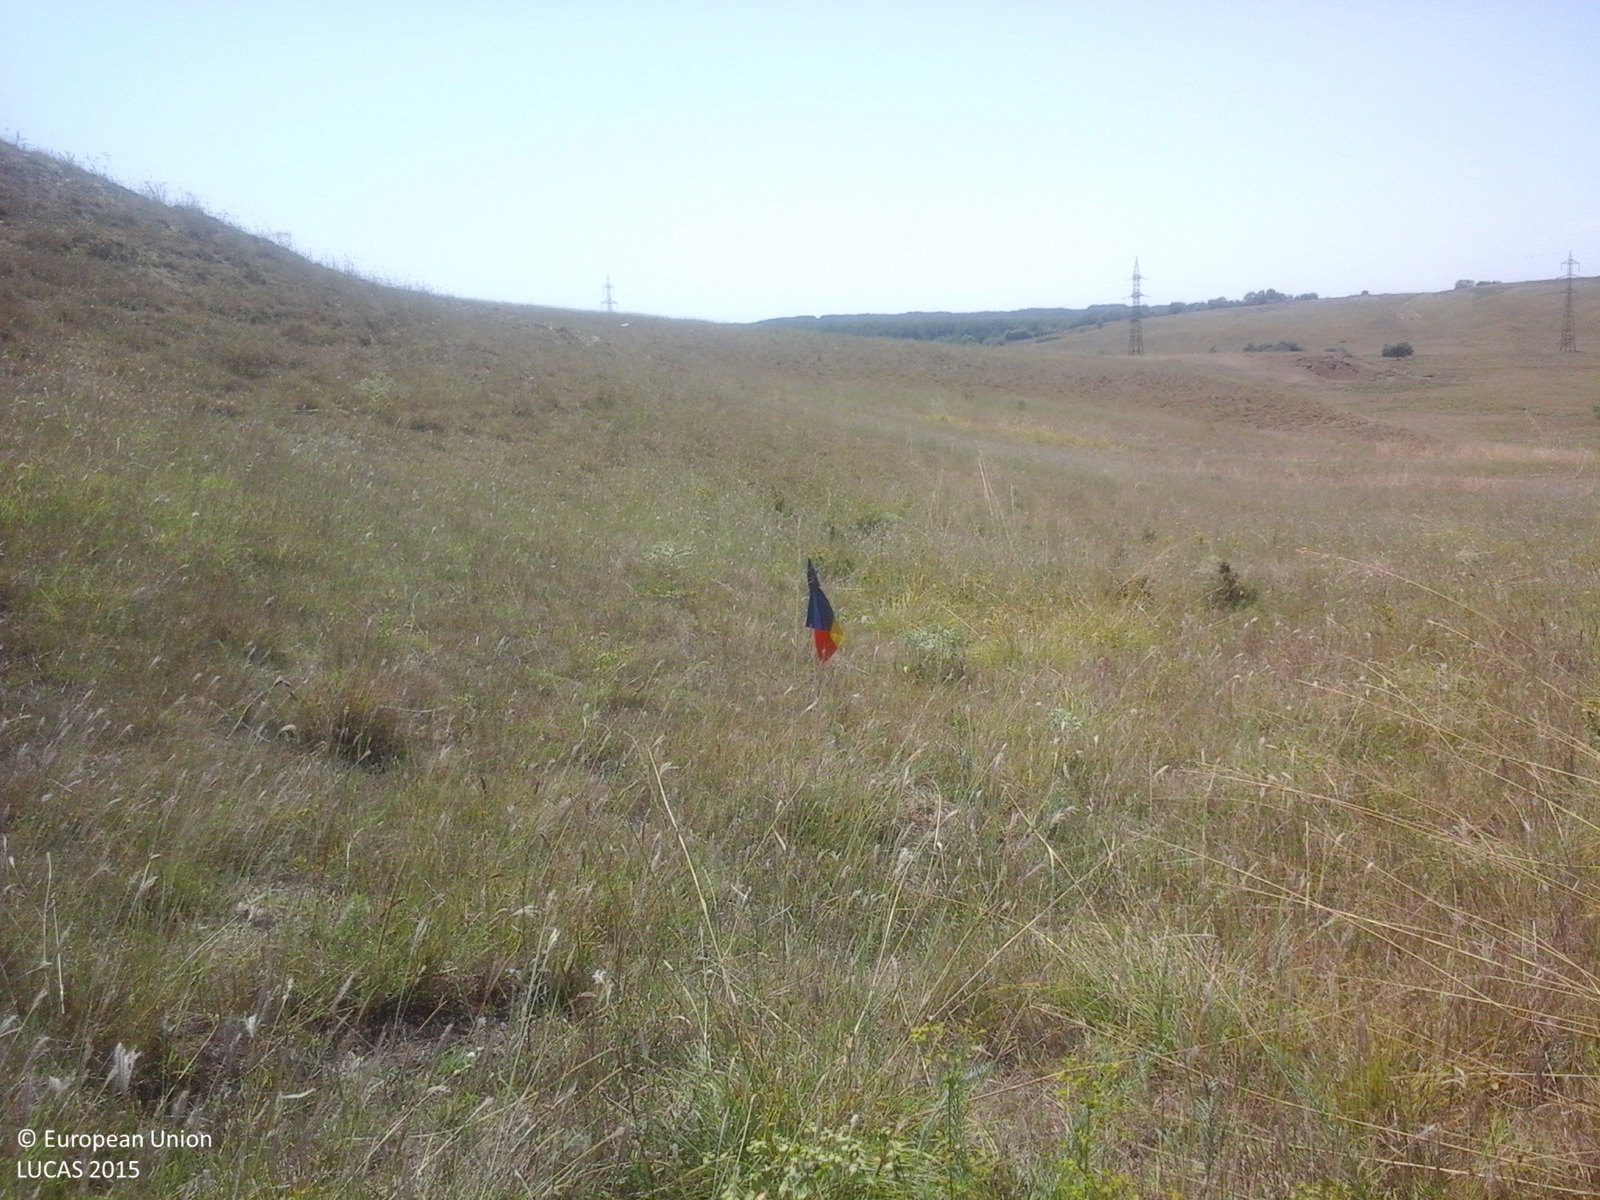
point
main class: Grassland
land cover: Grassland without tree/shrub cover
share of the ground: > 75 %
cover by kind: herbaceous plants 100 %
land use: Agriculture (excluding fallow land and kitchen gardens)
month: August
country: RO
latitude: 44.4939
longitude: 28.1066
